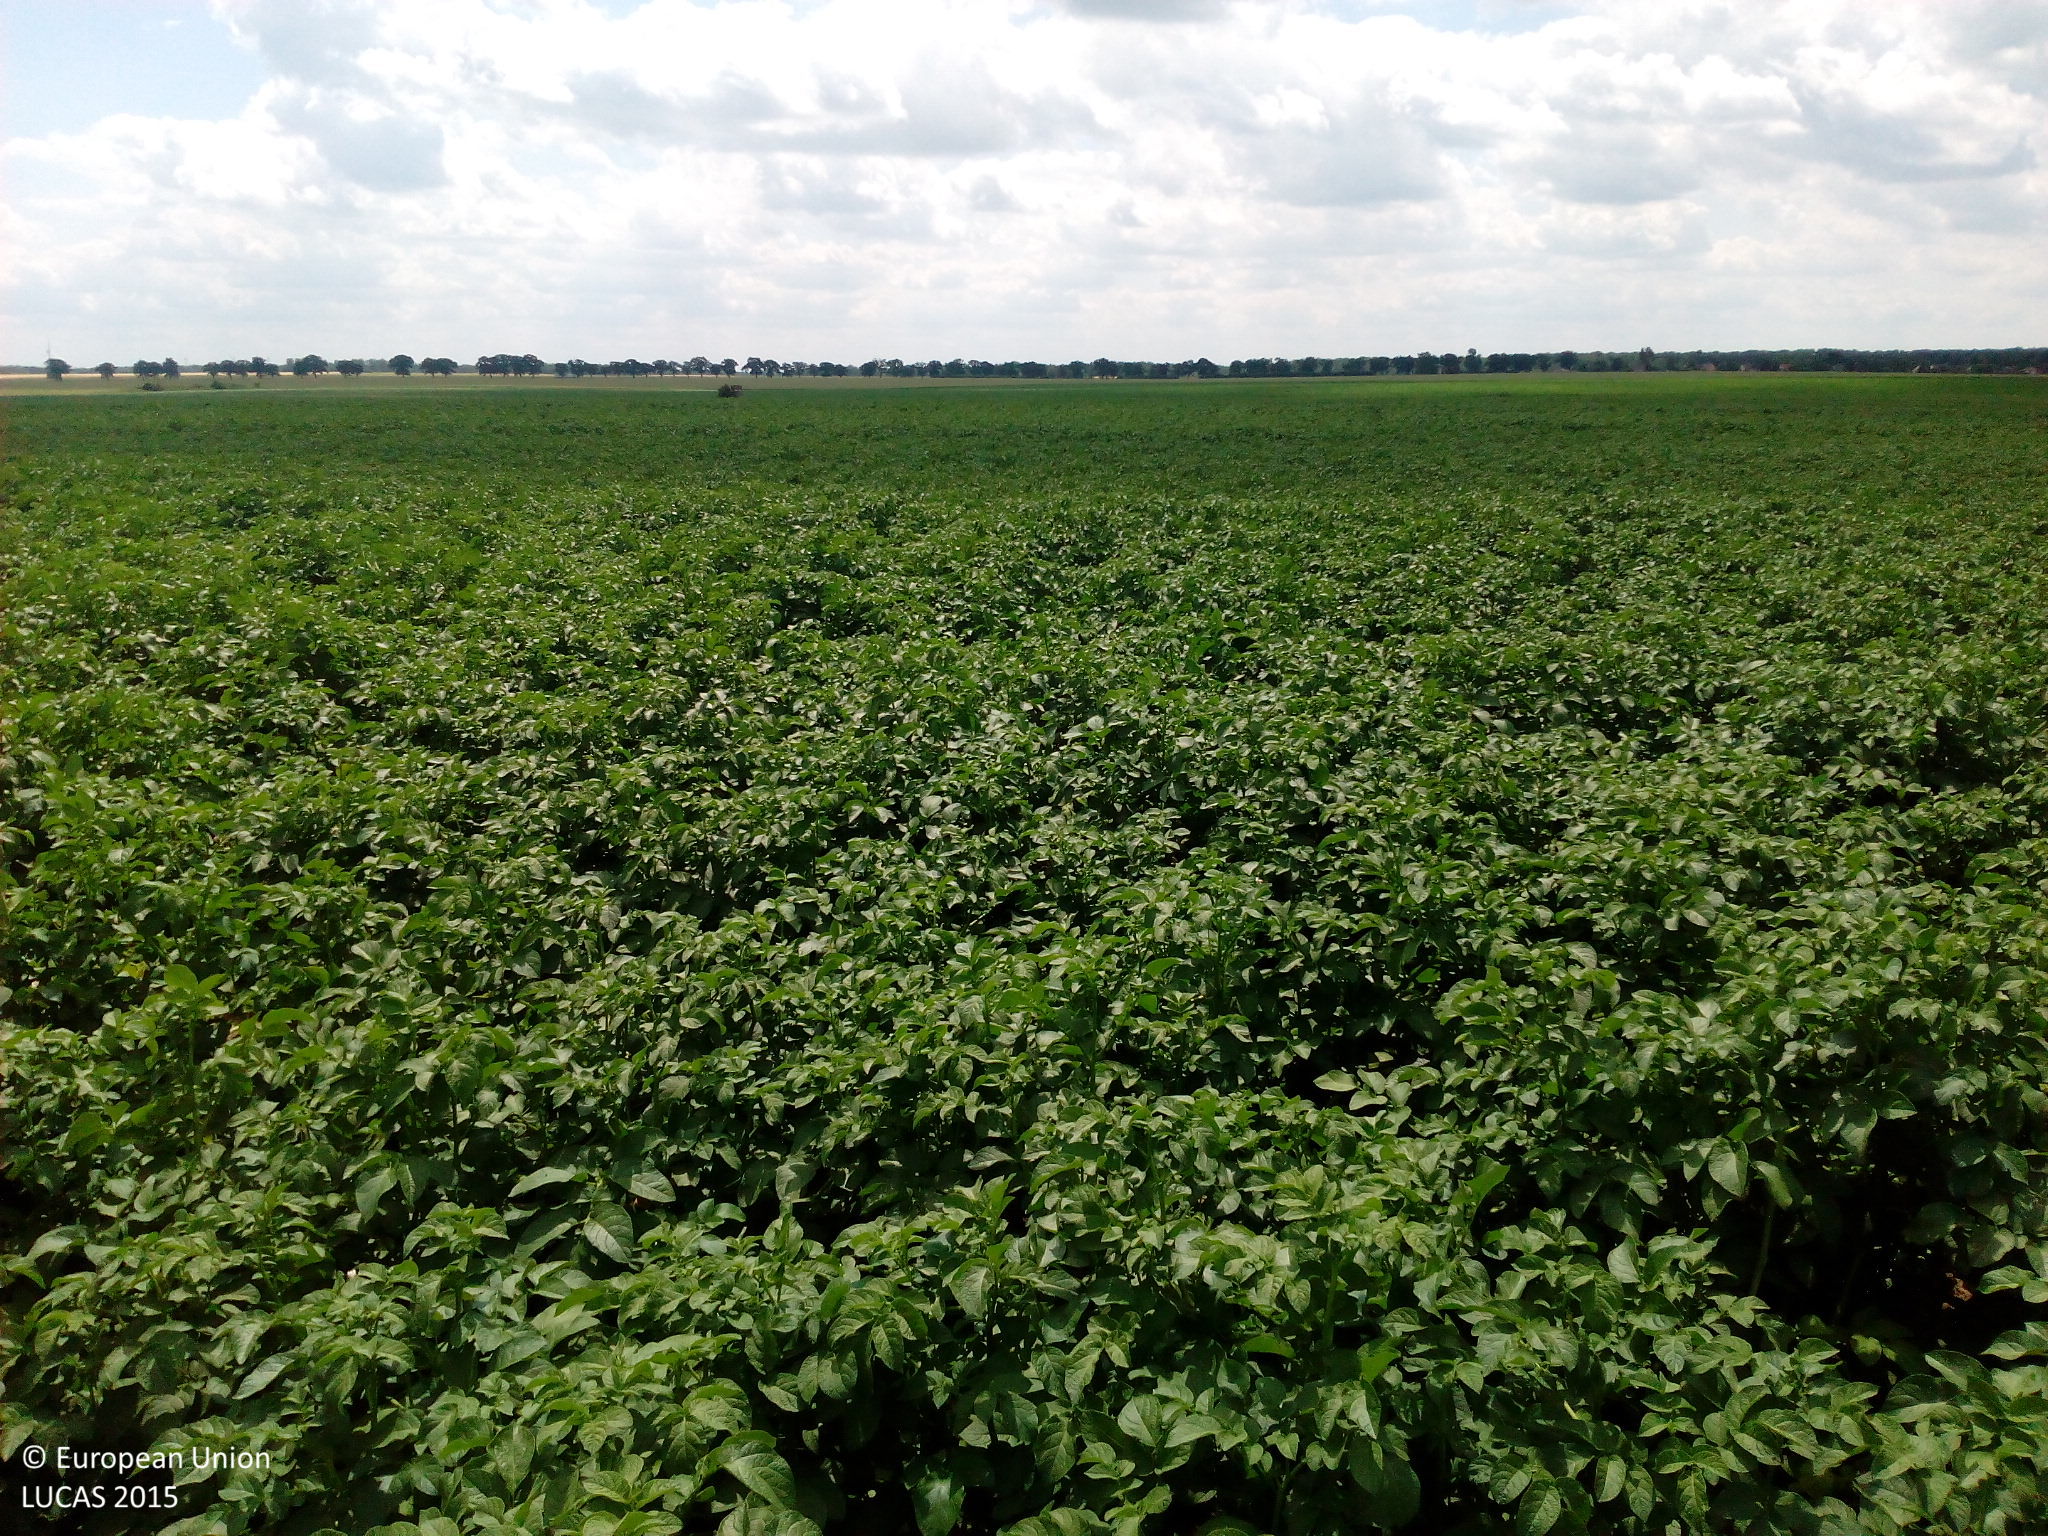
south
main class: Cropland
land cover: Potatoes
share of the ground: > 75 %
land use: Agriculture (excluding fallow land and kitchen gardens)
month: July
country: DE
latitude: 53.9333
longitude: 13.2741
